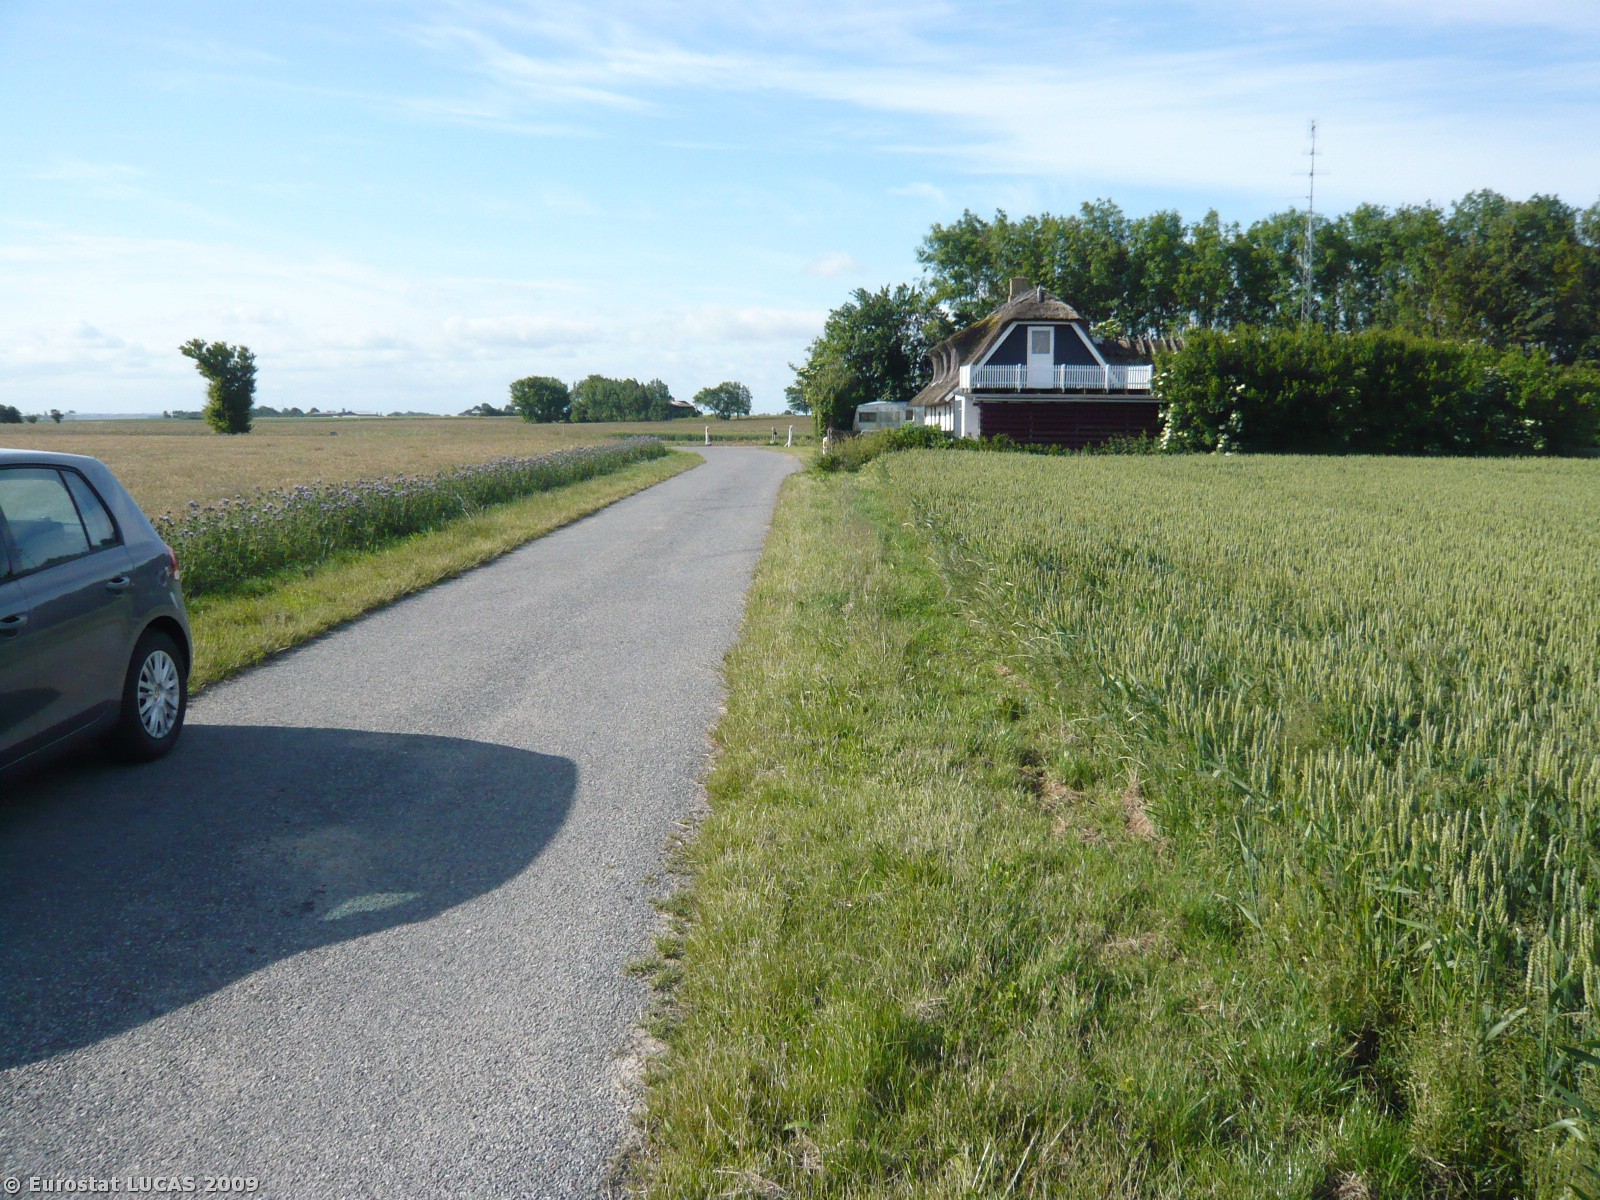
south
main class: Cropland
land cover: Common wheat
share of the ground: > 75 %
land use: Agriculture (excluding fallow land and kitchen gardens)
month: June
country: DK
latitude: 54.9249
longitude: 11.0759
